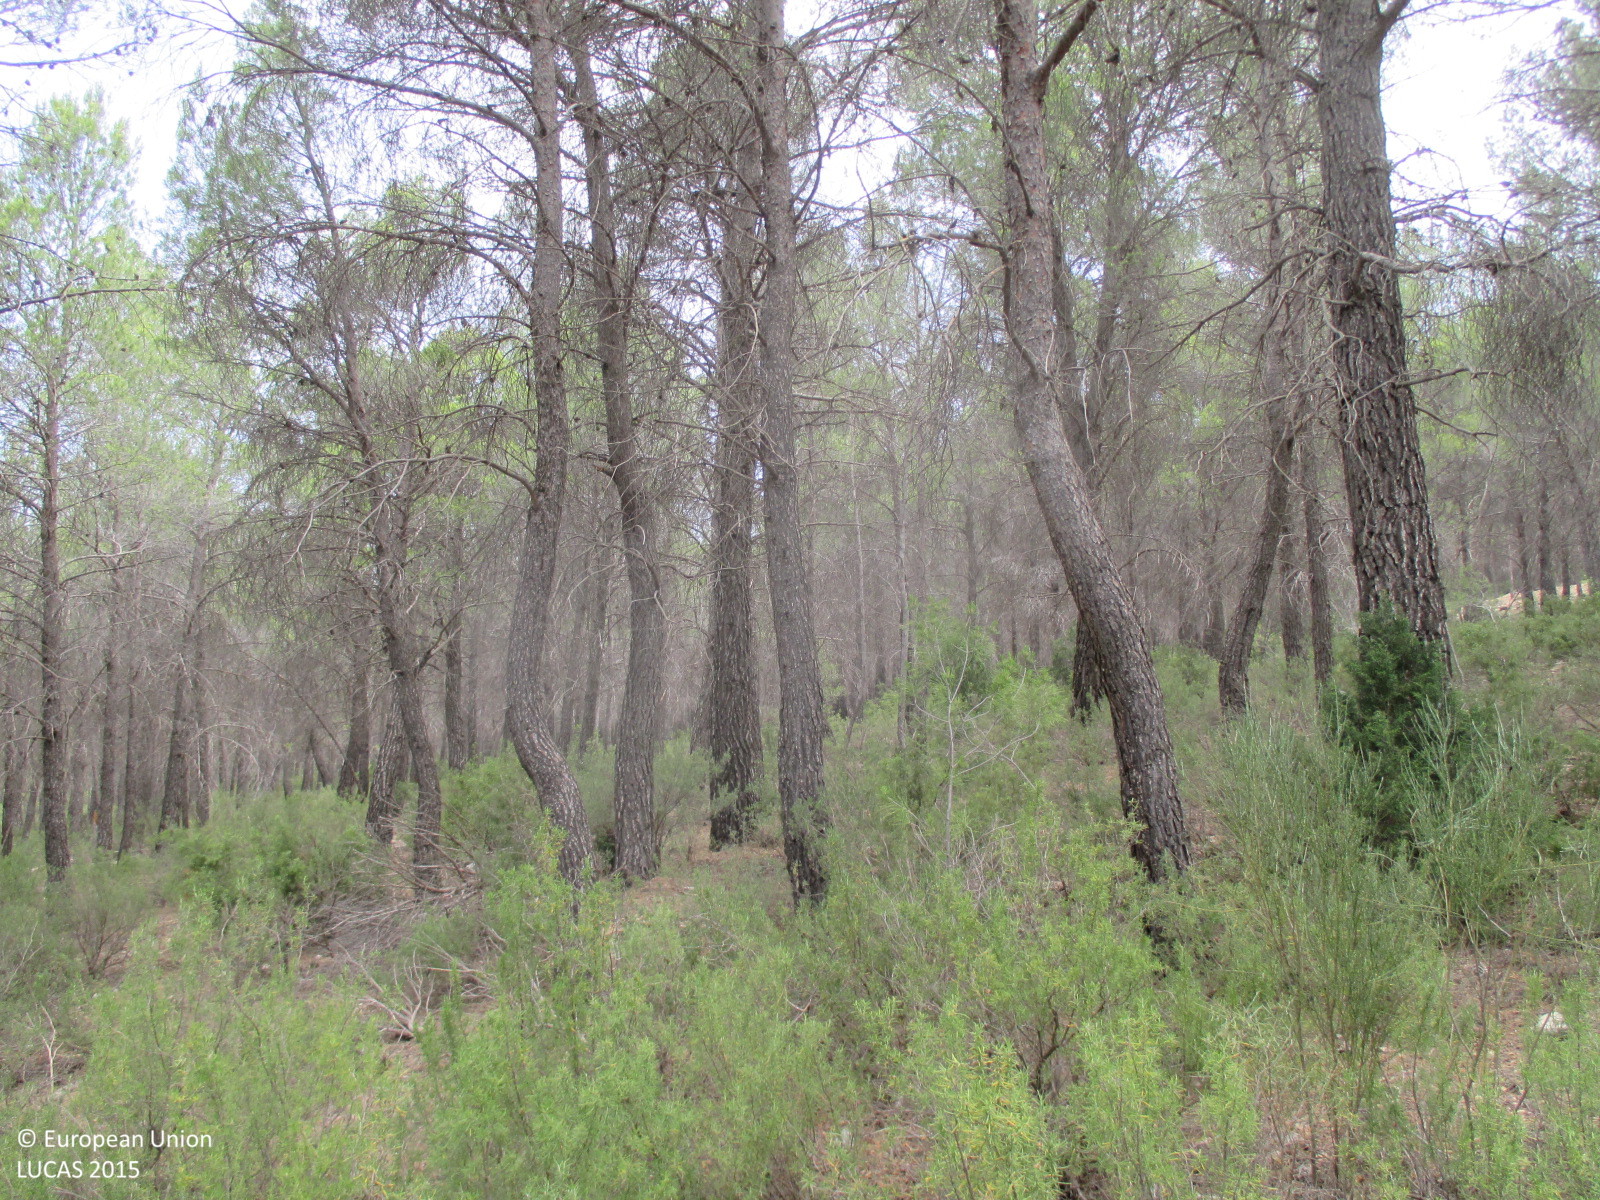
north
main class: Woodland
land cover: Pine dominated coniferous woodland
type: coniferous forest of the mediterranean region
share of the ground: > 75 %
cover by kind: coniferous forest trees 90 %, shrubs 10 %
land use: Forestry
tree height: > 5 m
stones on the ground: < 10 %
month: July
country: ES
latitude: 37.9279
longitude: -2.4943
